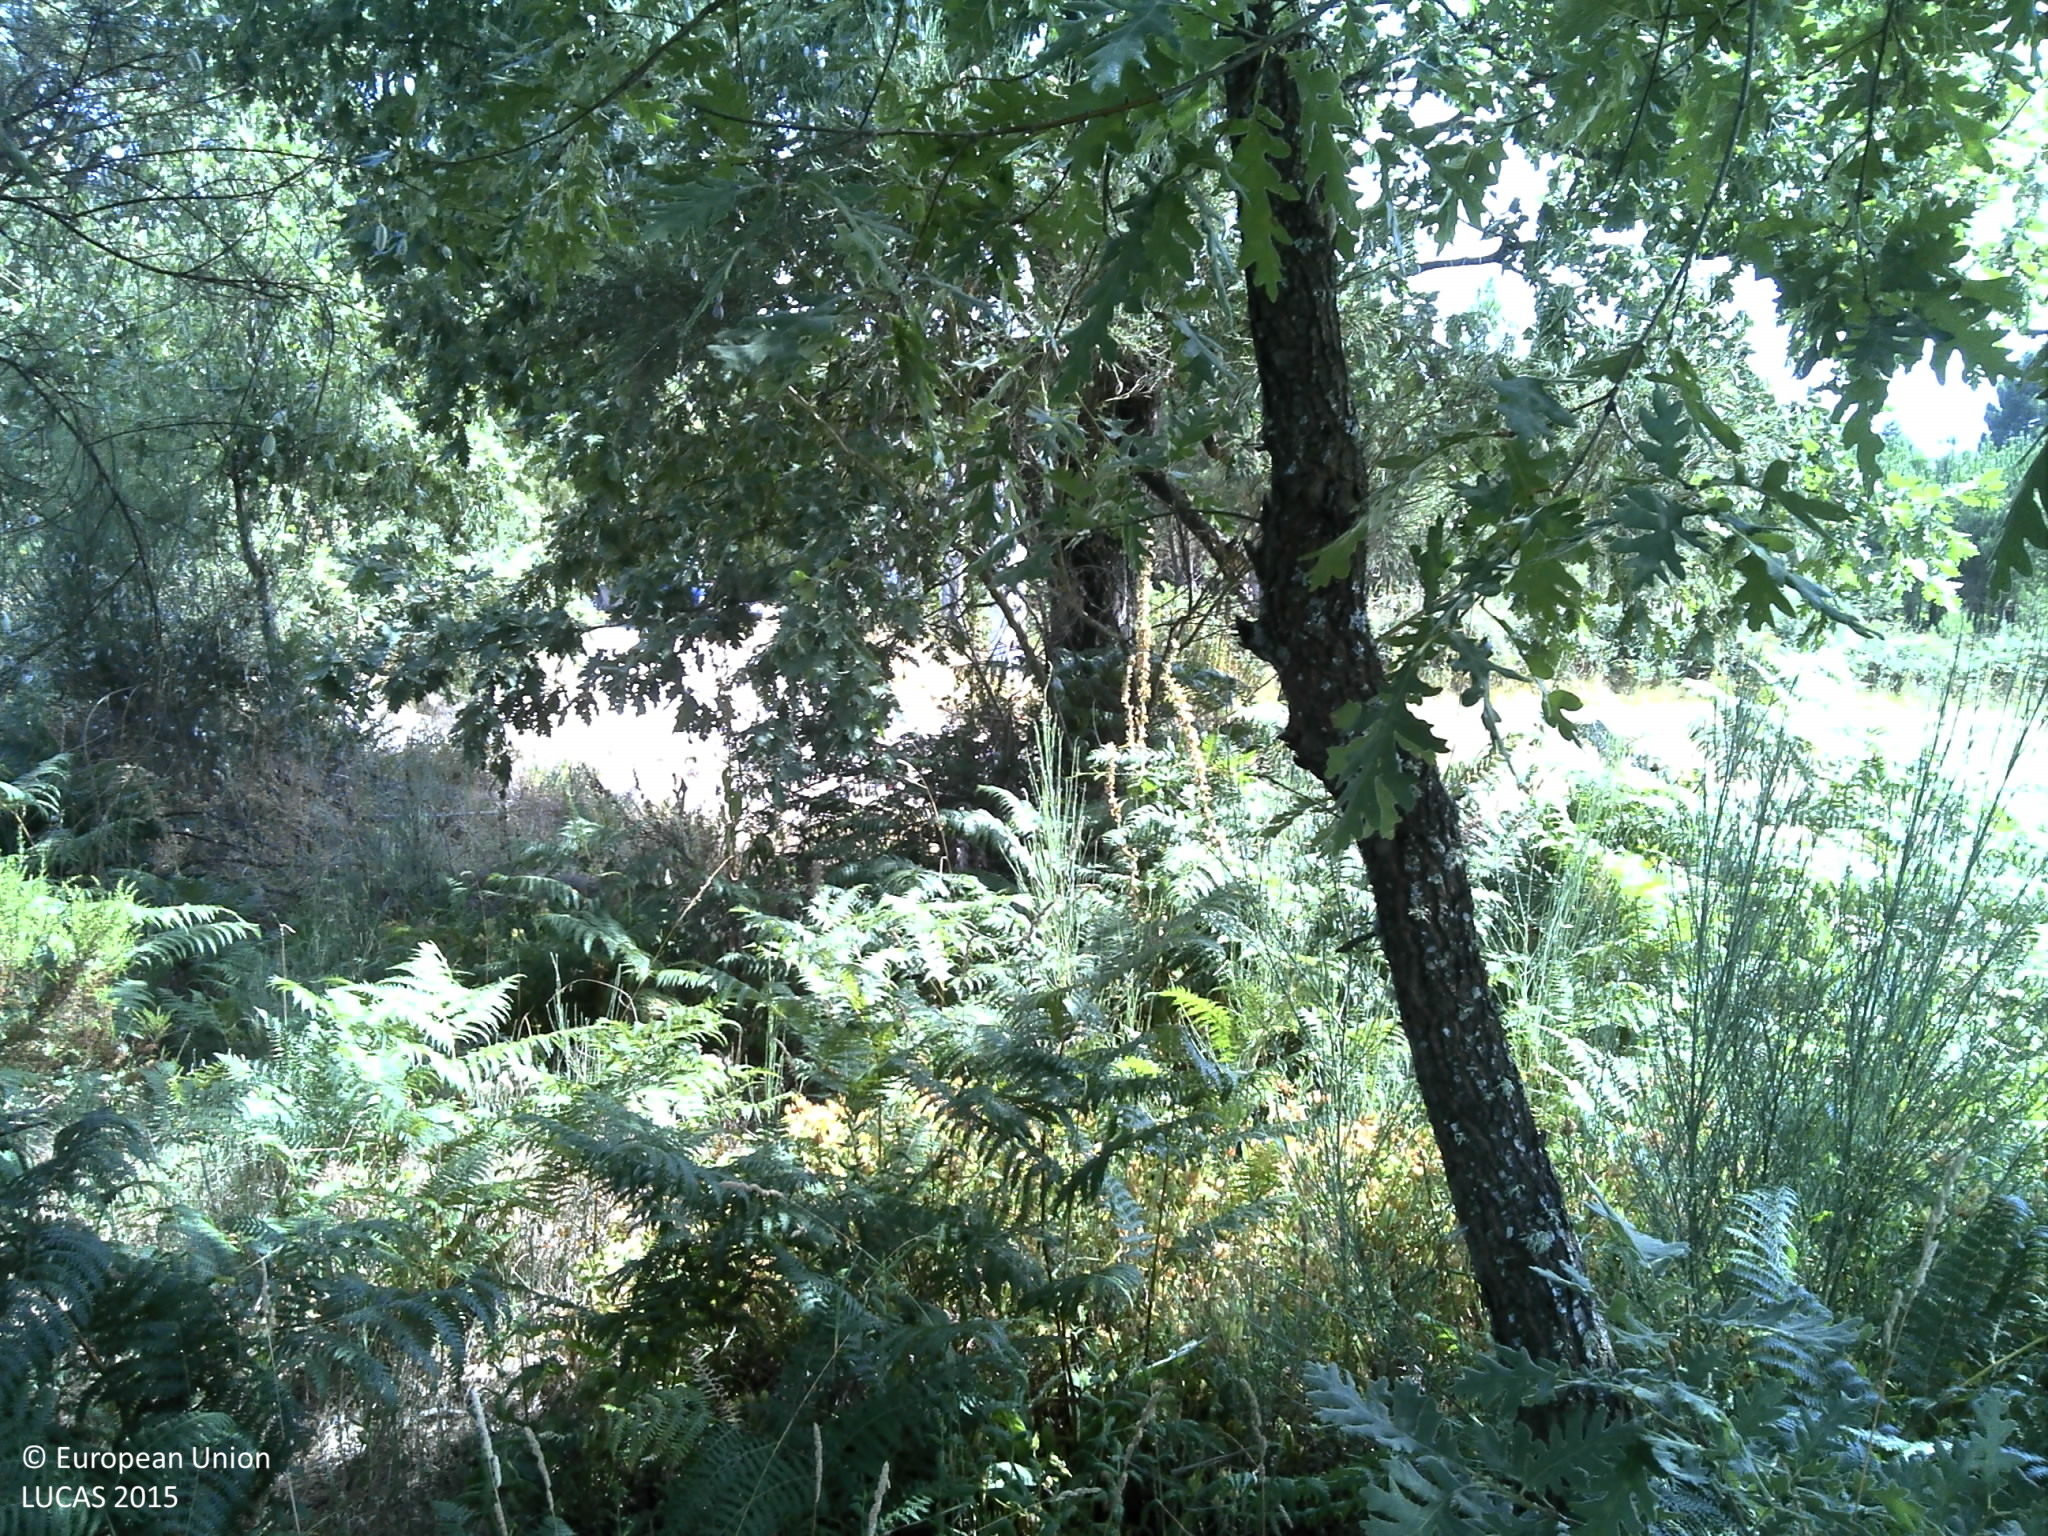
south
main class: Shrubland
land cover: Shrubland with sparse tree cover
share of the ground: 50 - 75 %
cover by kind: shrubs 55 %, unconsolidated bare surface 30 %, herbaceous plants 10 %, broadleaved forest trees 5 %
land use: Forestry
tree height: > 5 m
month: July
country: PT
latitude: 40.8948
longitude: -7.6042
